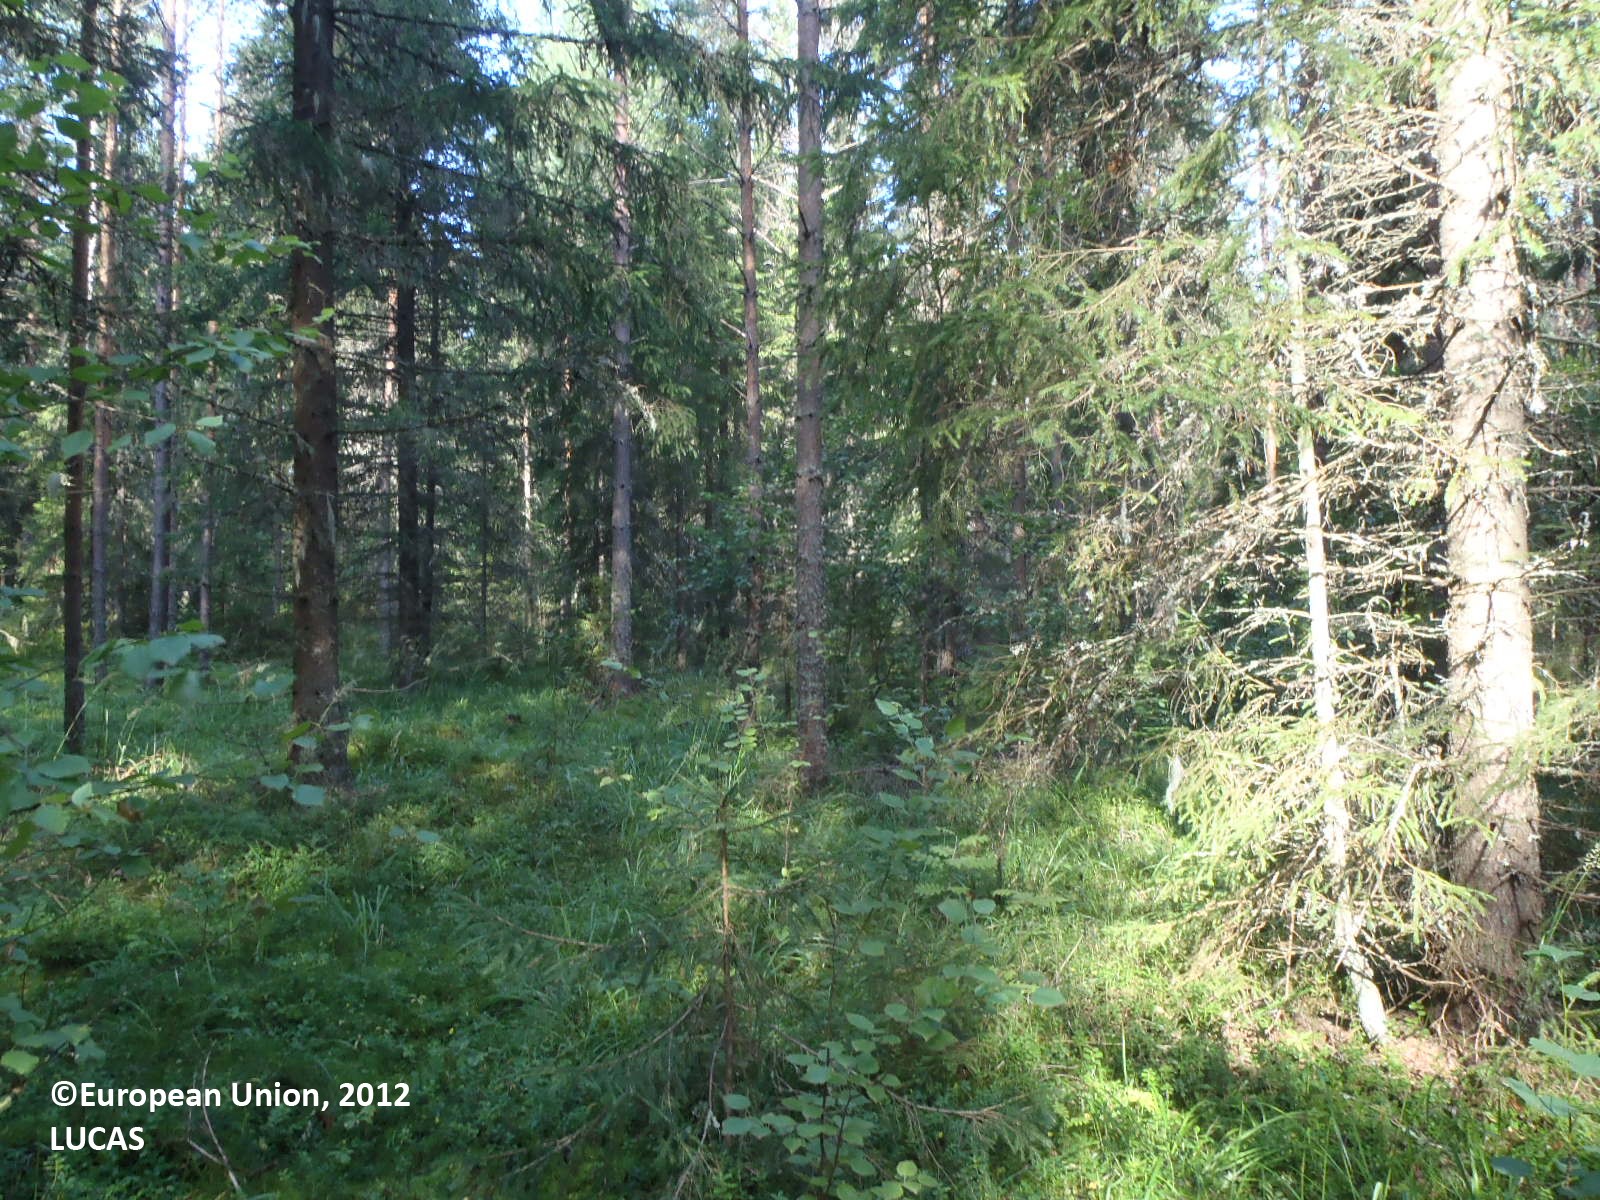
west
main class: Woodland
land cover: Pine dominated mixed woodland
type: boreal forest
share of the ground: > 75 %
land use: Forestry
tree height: > 5 m
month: August
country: FI
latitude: 60.9376
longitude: 21.8509
